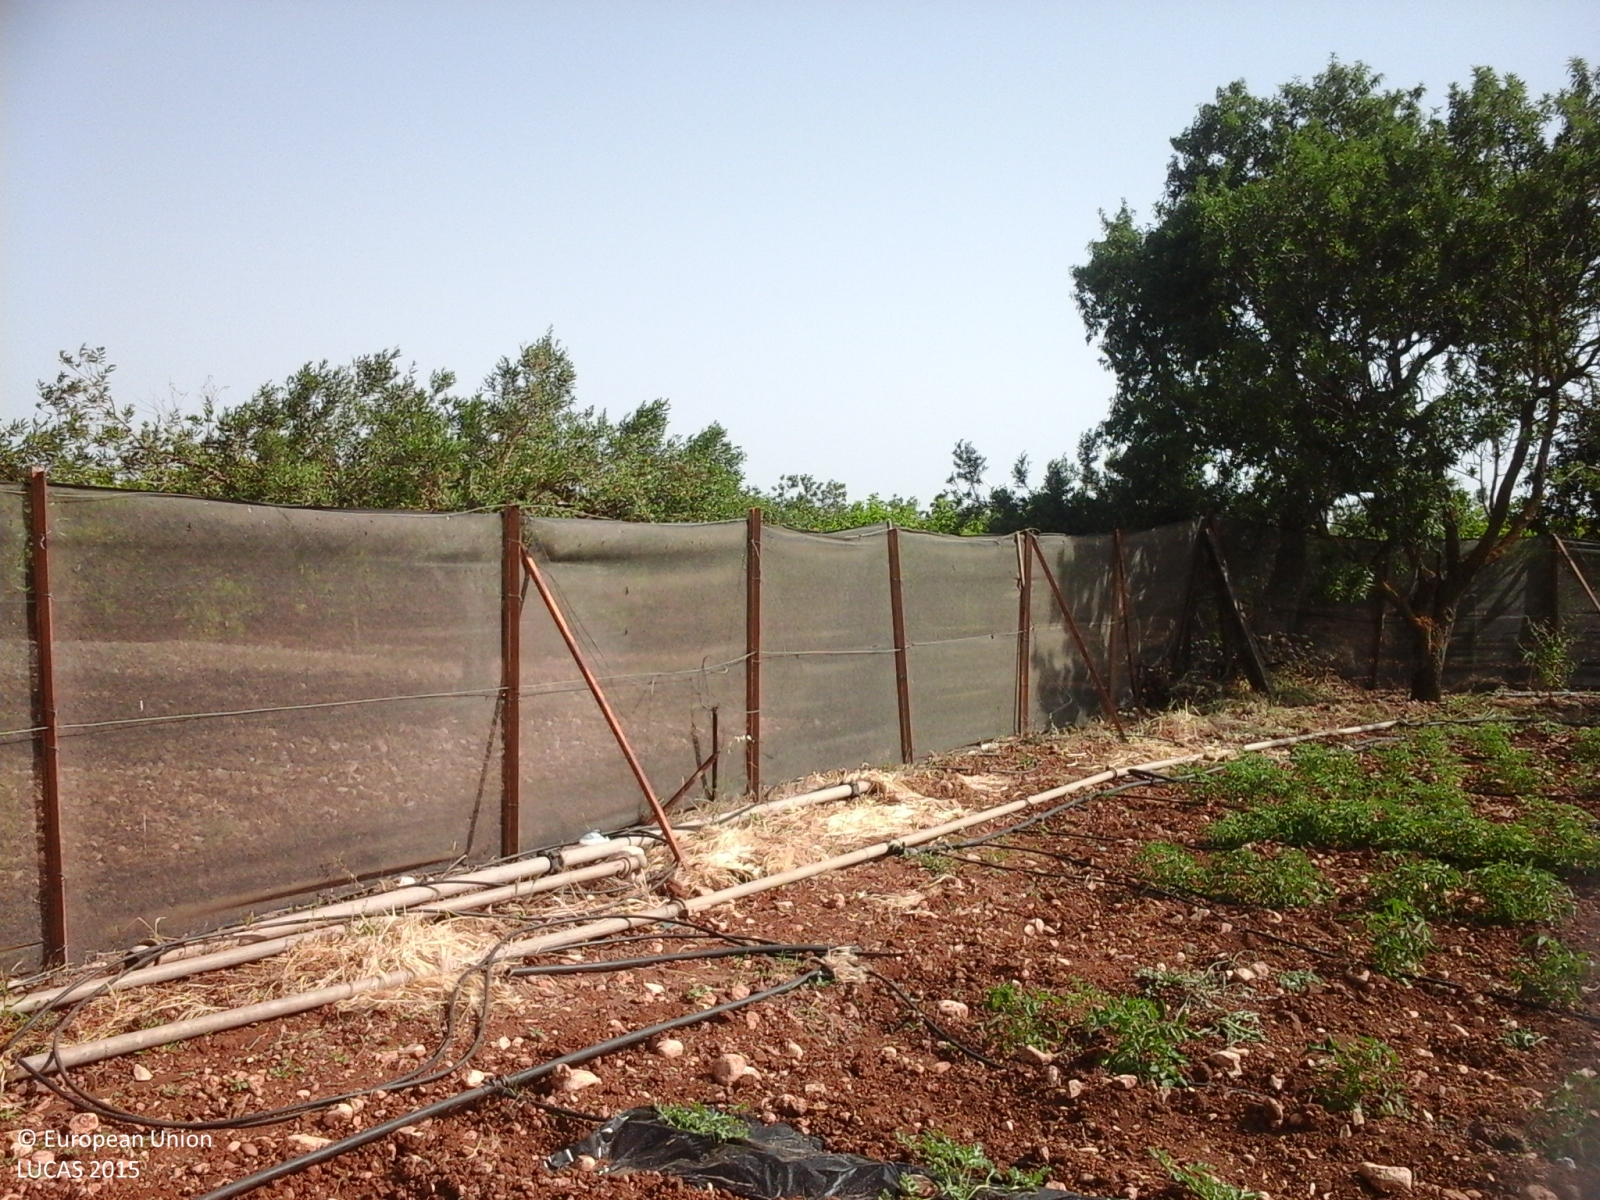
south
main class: Cropland
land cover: Other fresh vegetables
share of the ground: 10 - 25 %
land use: Agriculture (excluding fallow land and kitchen gardens)
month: May
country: IT
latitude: 37.5709
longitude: 13.0676
